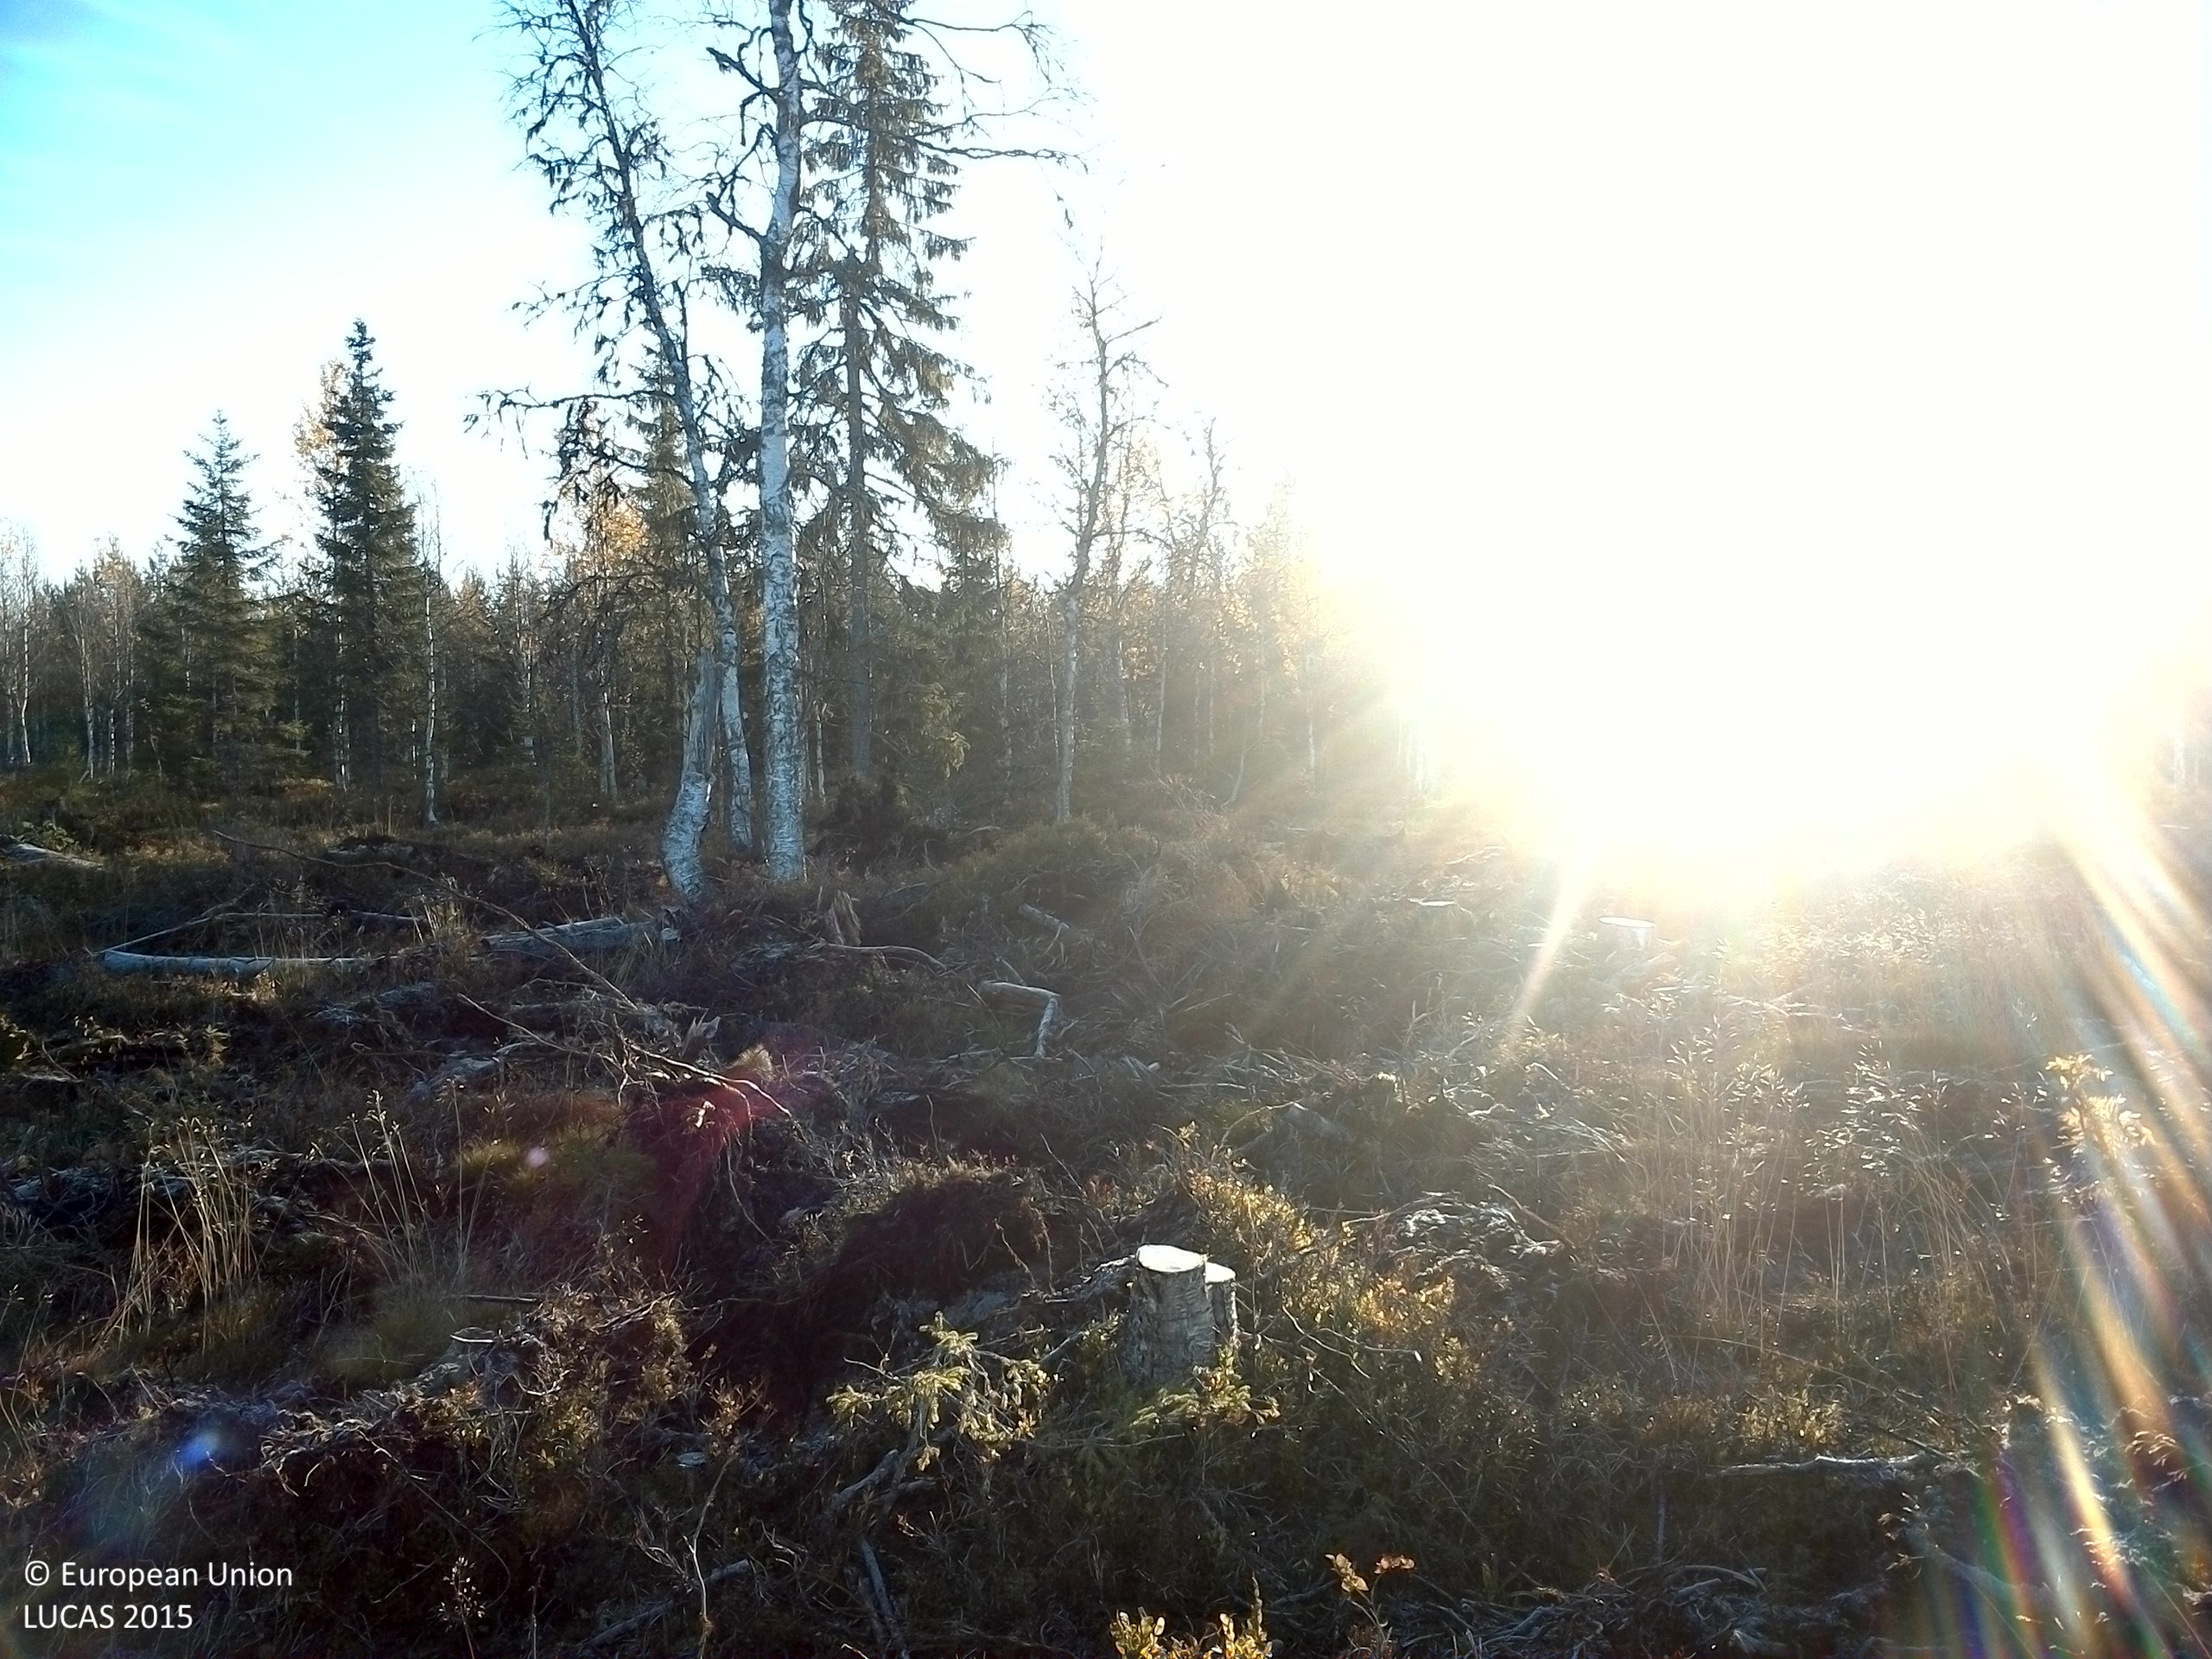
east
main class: Shrubland
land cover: Shrubland without tree cover
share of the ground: 25 - 50 %
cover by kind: shrubs 30 %, herbaceous plants 20 %, lichens and mosses 20 %, unconsolidated bare surface 10 %
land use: Forestry
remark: Clear cut
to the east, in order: Shrubland without tree cover; Spruce dominated mixed woodland; Pine dominated mixed woodland; Broadleaved woodland
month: October
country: SE
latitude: 64.2839
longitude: 16.0221
